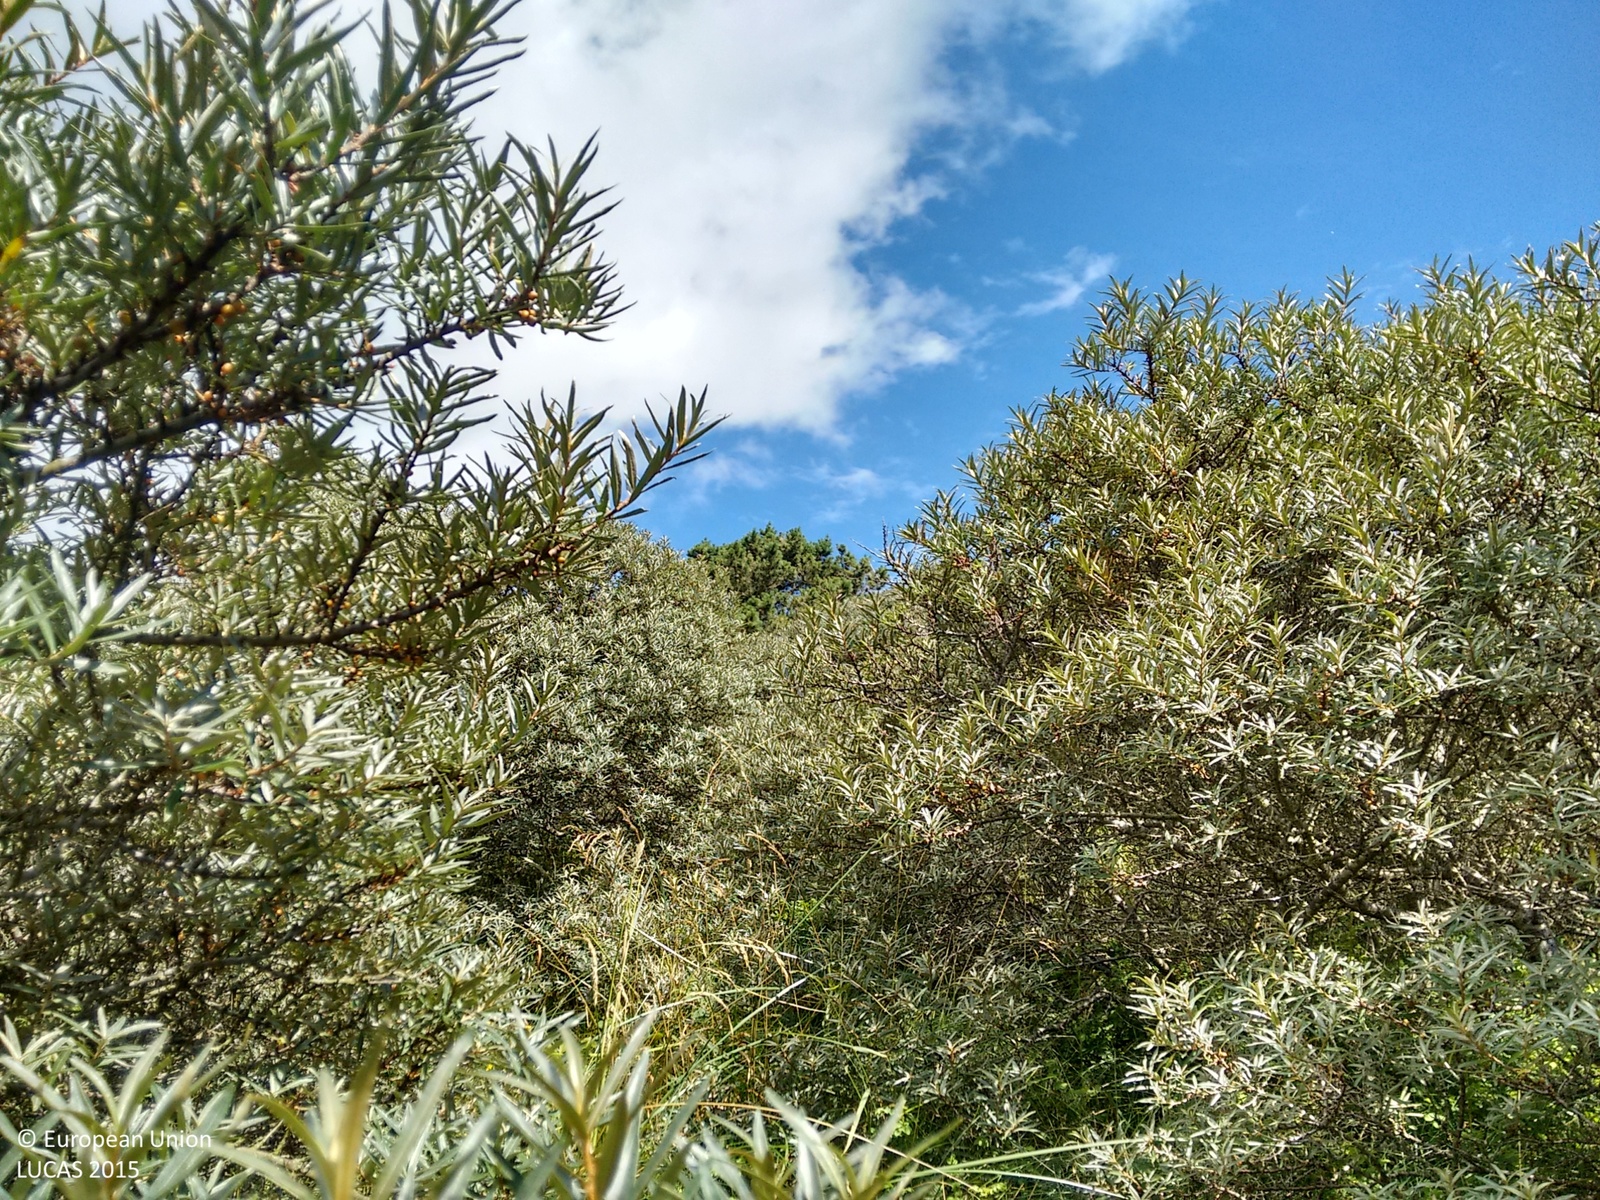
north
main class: Shrubland
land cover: Shrubland without tree cover
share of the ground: > 75 %
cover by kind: shrubs 95 %, herbaceous plants 5 %
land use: Semi-natural and natural areas not in use
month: August
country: IE
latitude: 52.7075
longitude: -6.1770
